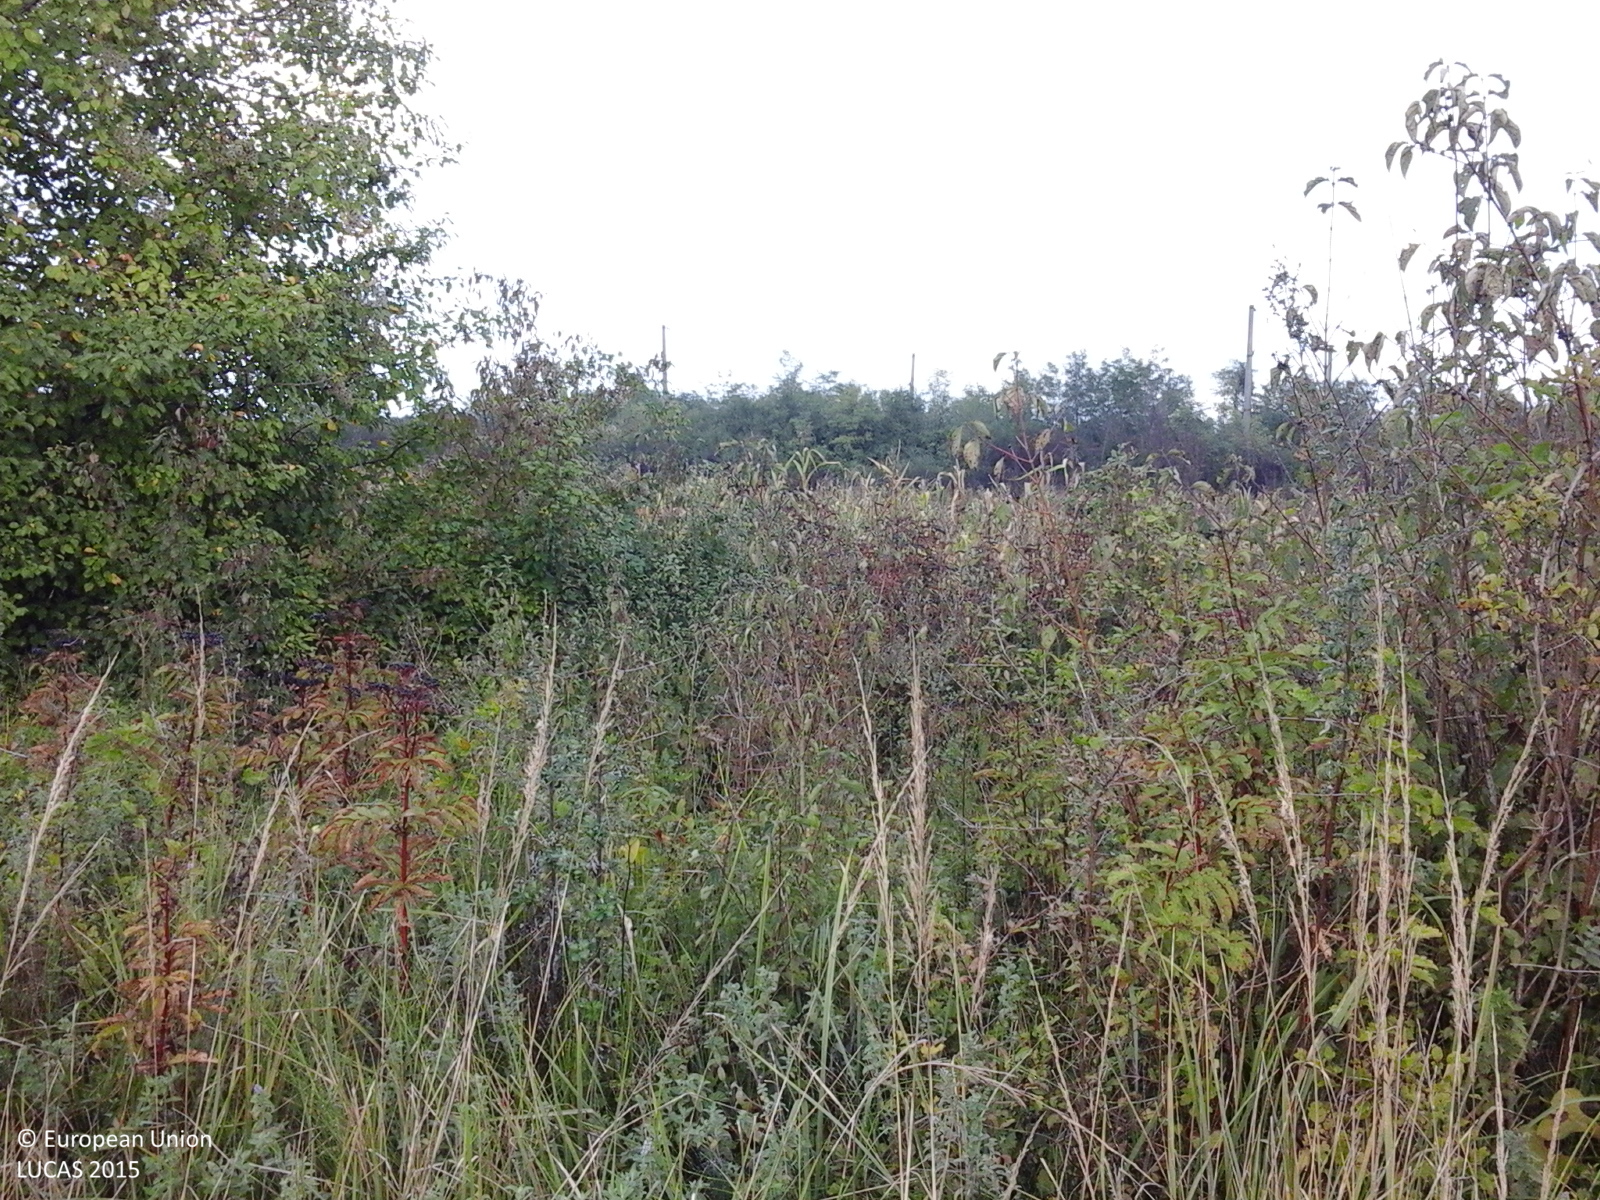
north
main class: Grassland
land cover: Spontaneously vegetated surfaces
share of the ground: > 75 %
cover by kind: herbaceous plants 100 %
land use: Forestry
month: September
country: RO
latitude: 45.0151
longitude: 23.3662
